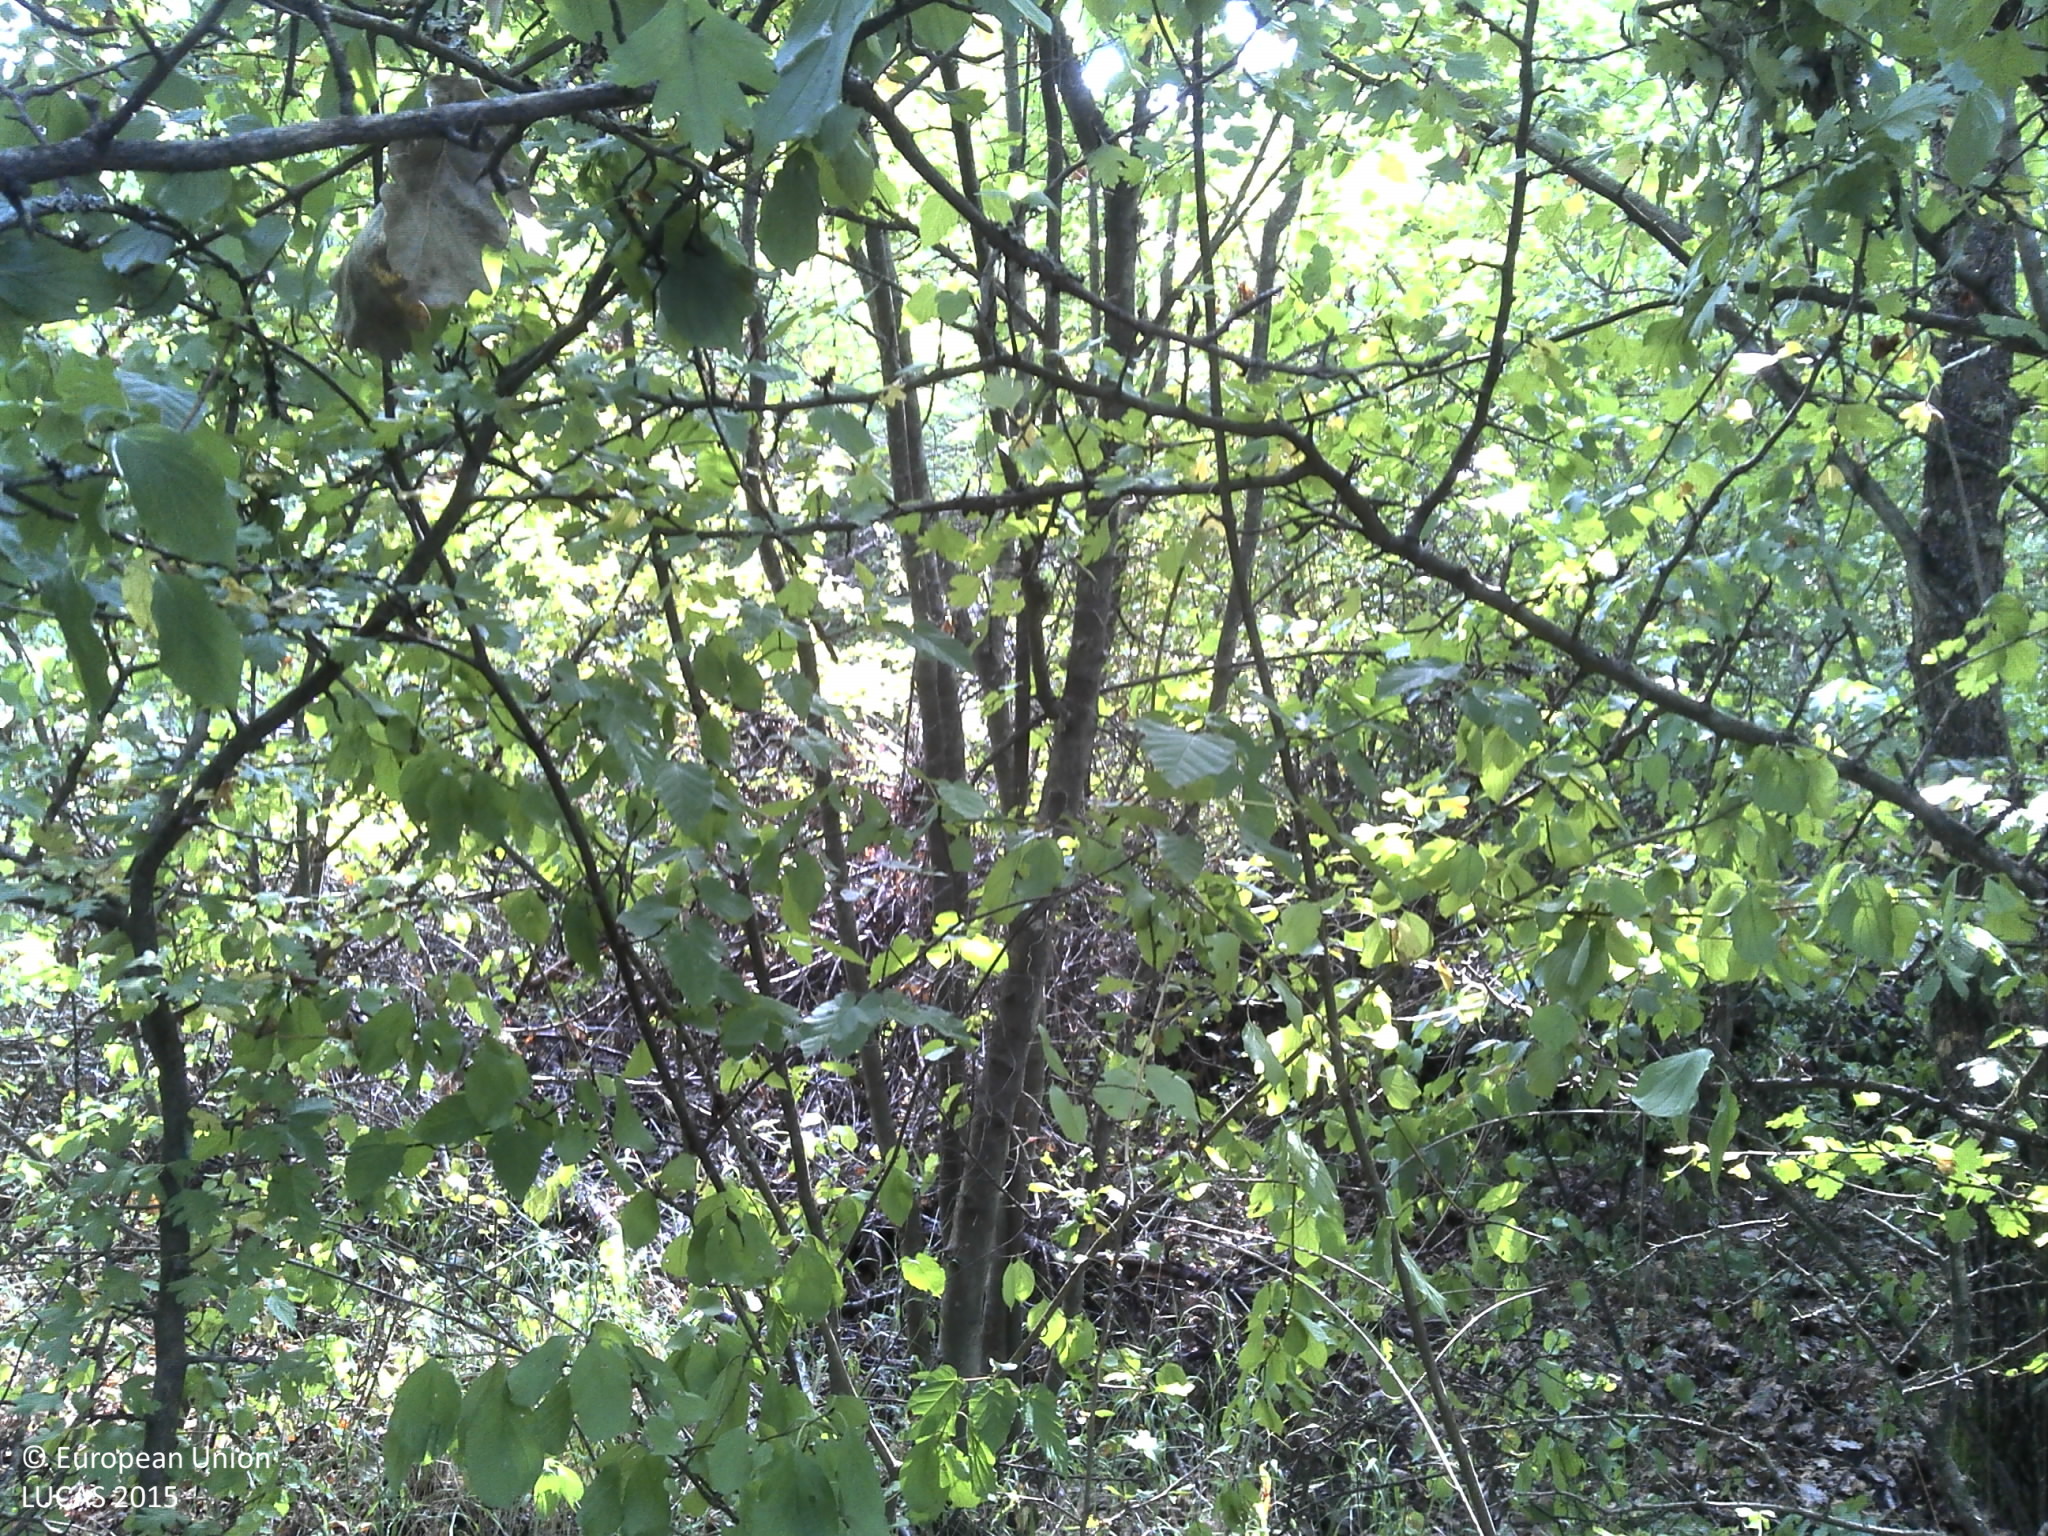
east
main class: Shrubland
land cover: Shrubland with sparse tree cover
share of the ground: > 75 %
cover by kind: shrubs 95 %, broadleaved forest trees 5 %
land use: Semi-natural and natural areas not in use
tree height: < 5 m
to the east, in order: Shrubland with sparse tree cover
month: August
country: HR
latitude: 45.2935
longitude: 18.2029
